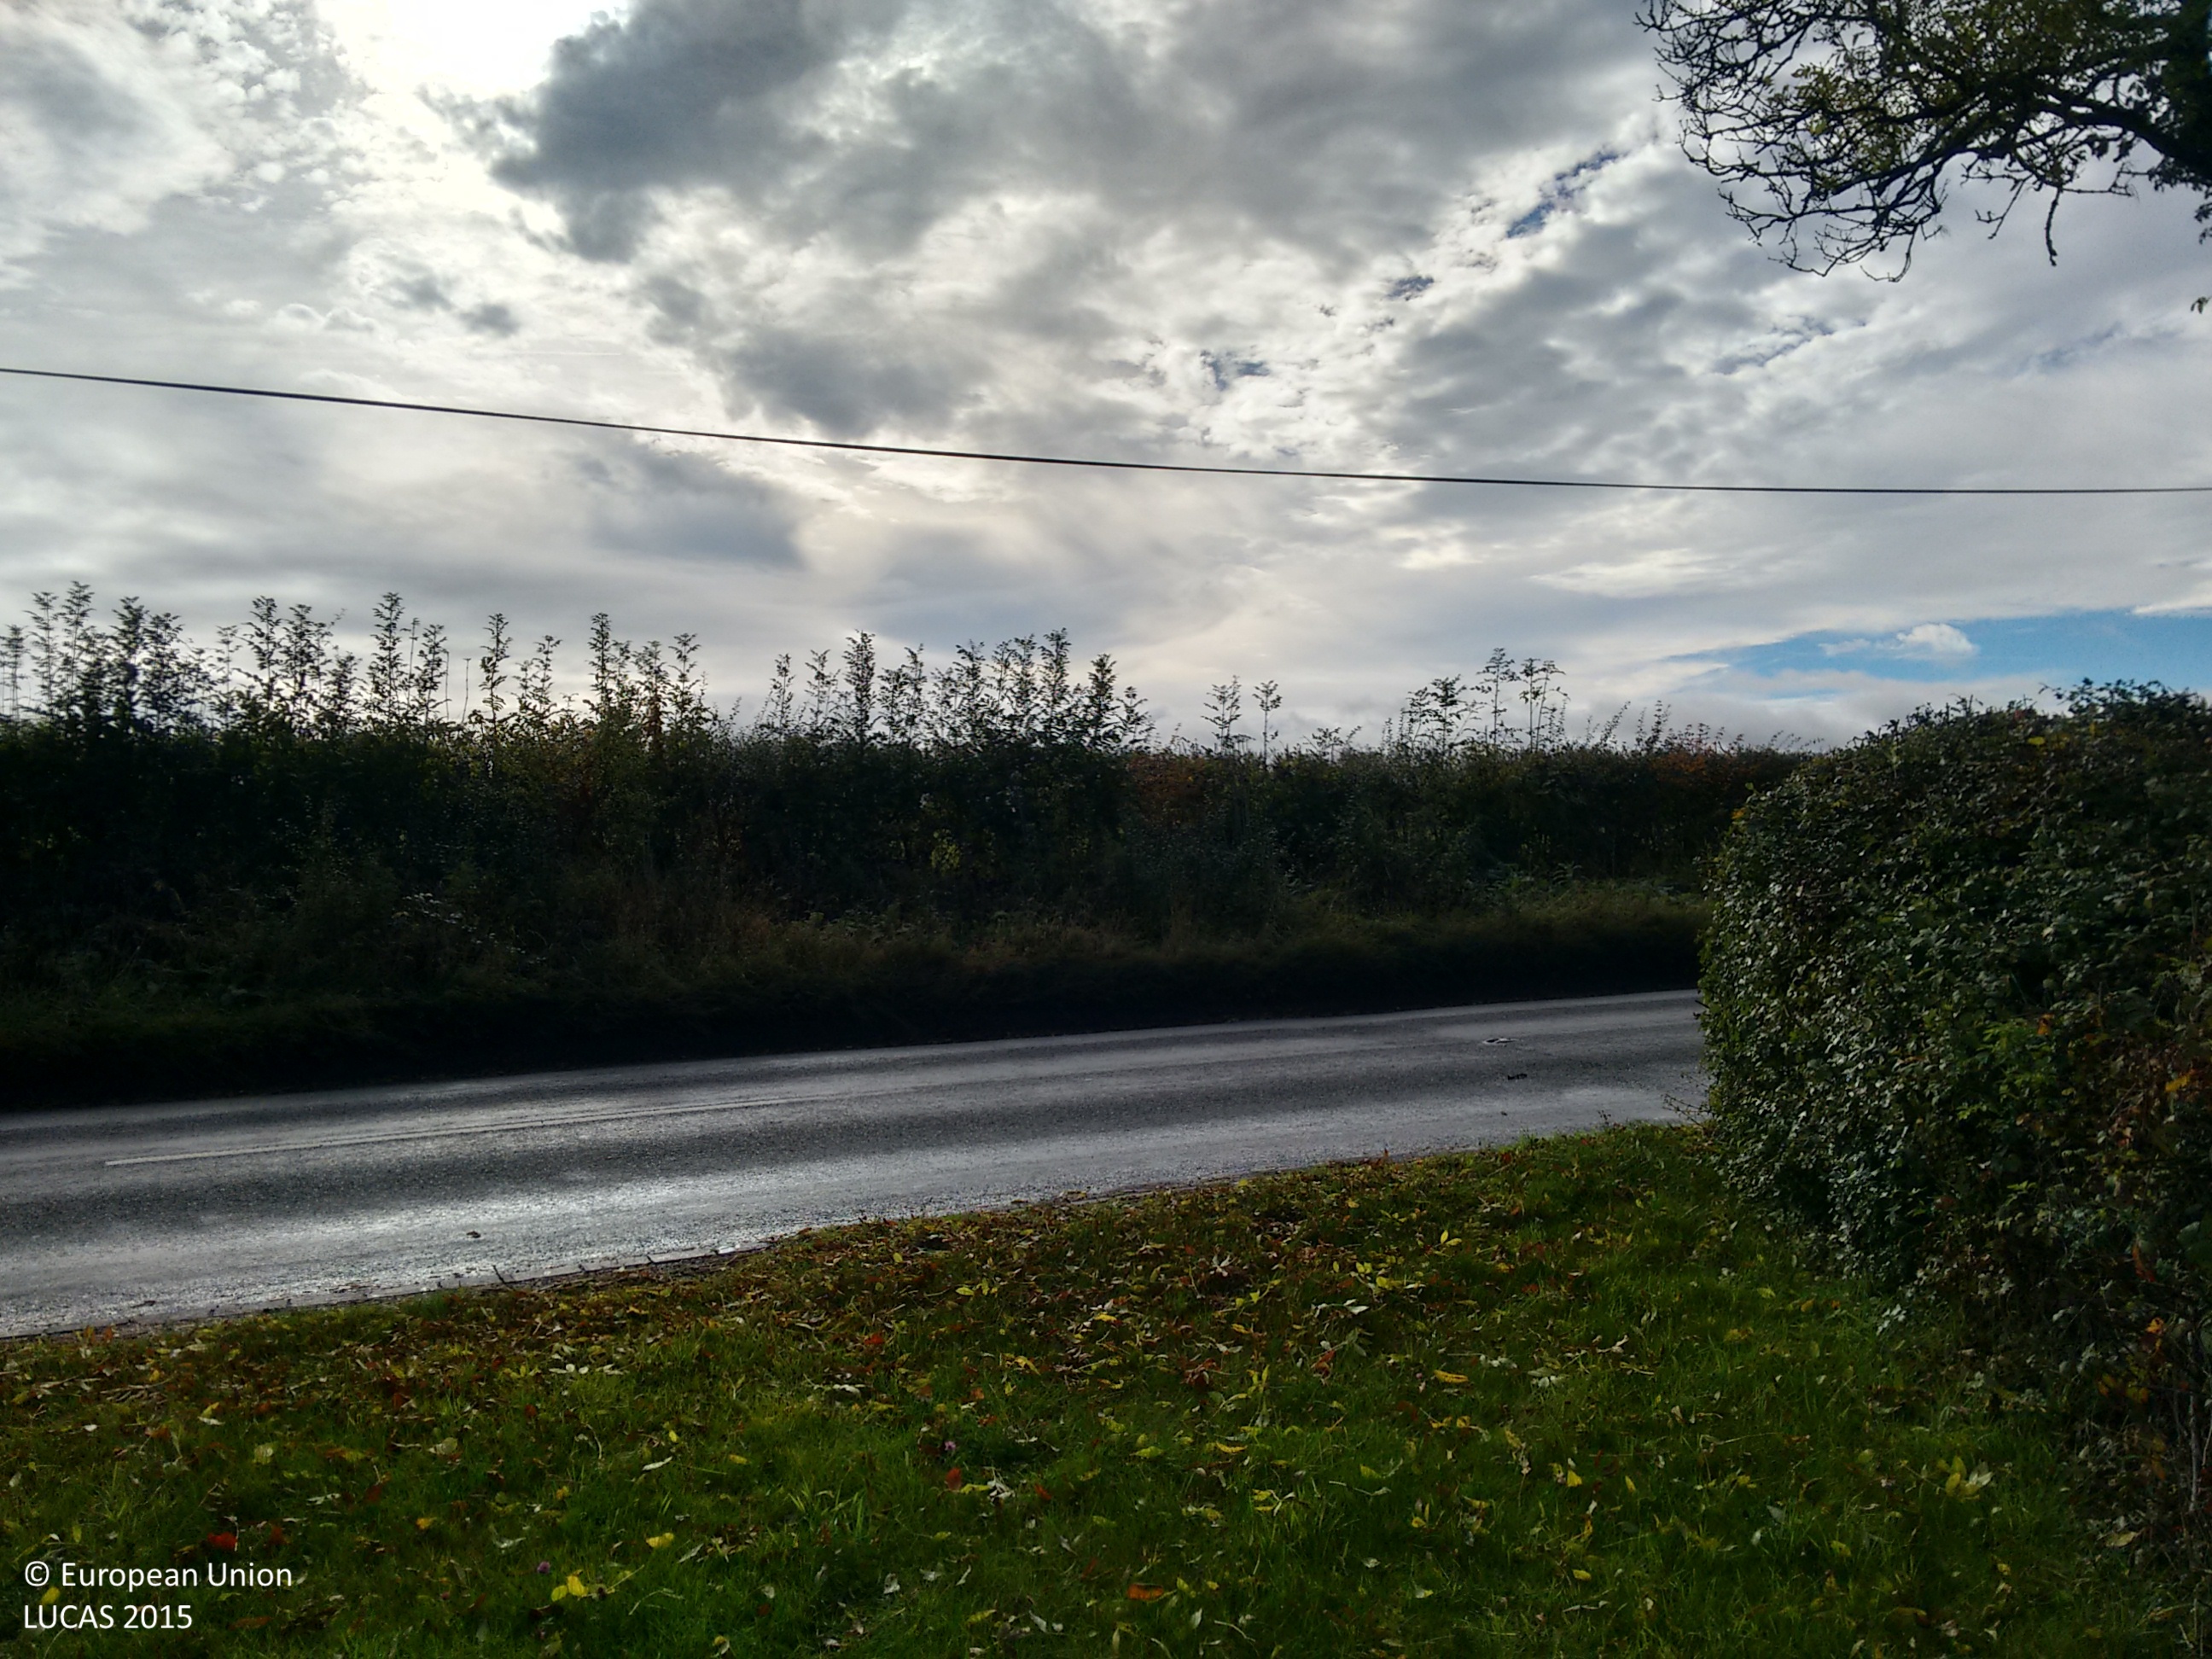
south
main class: Grassland
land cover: Grassland without tree/shrub cover
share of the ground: > 75 %
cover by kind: herbaceous plants 100 %
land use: Agriculture (excluding fallow land and kitchen gardens)
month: October
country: GB
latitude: 52.0505
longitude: -1.7053
